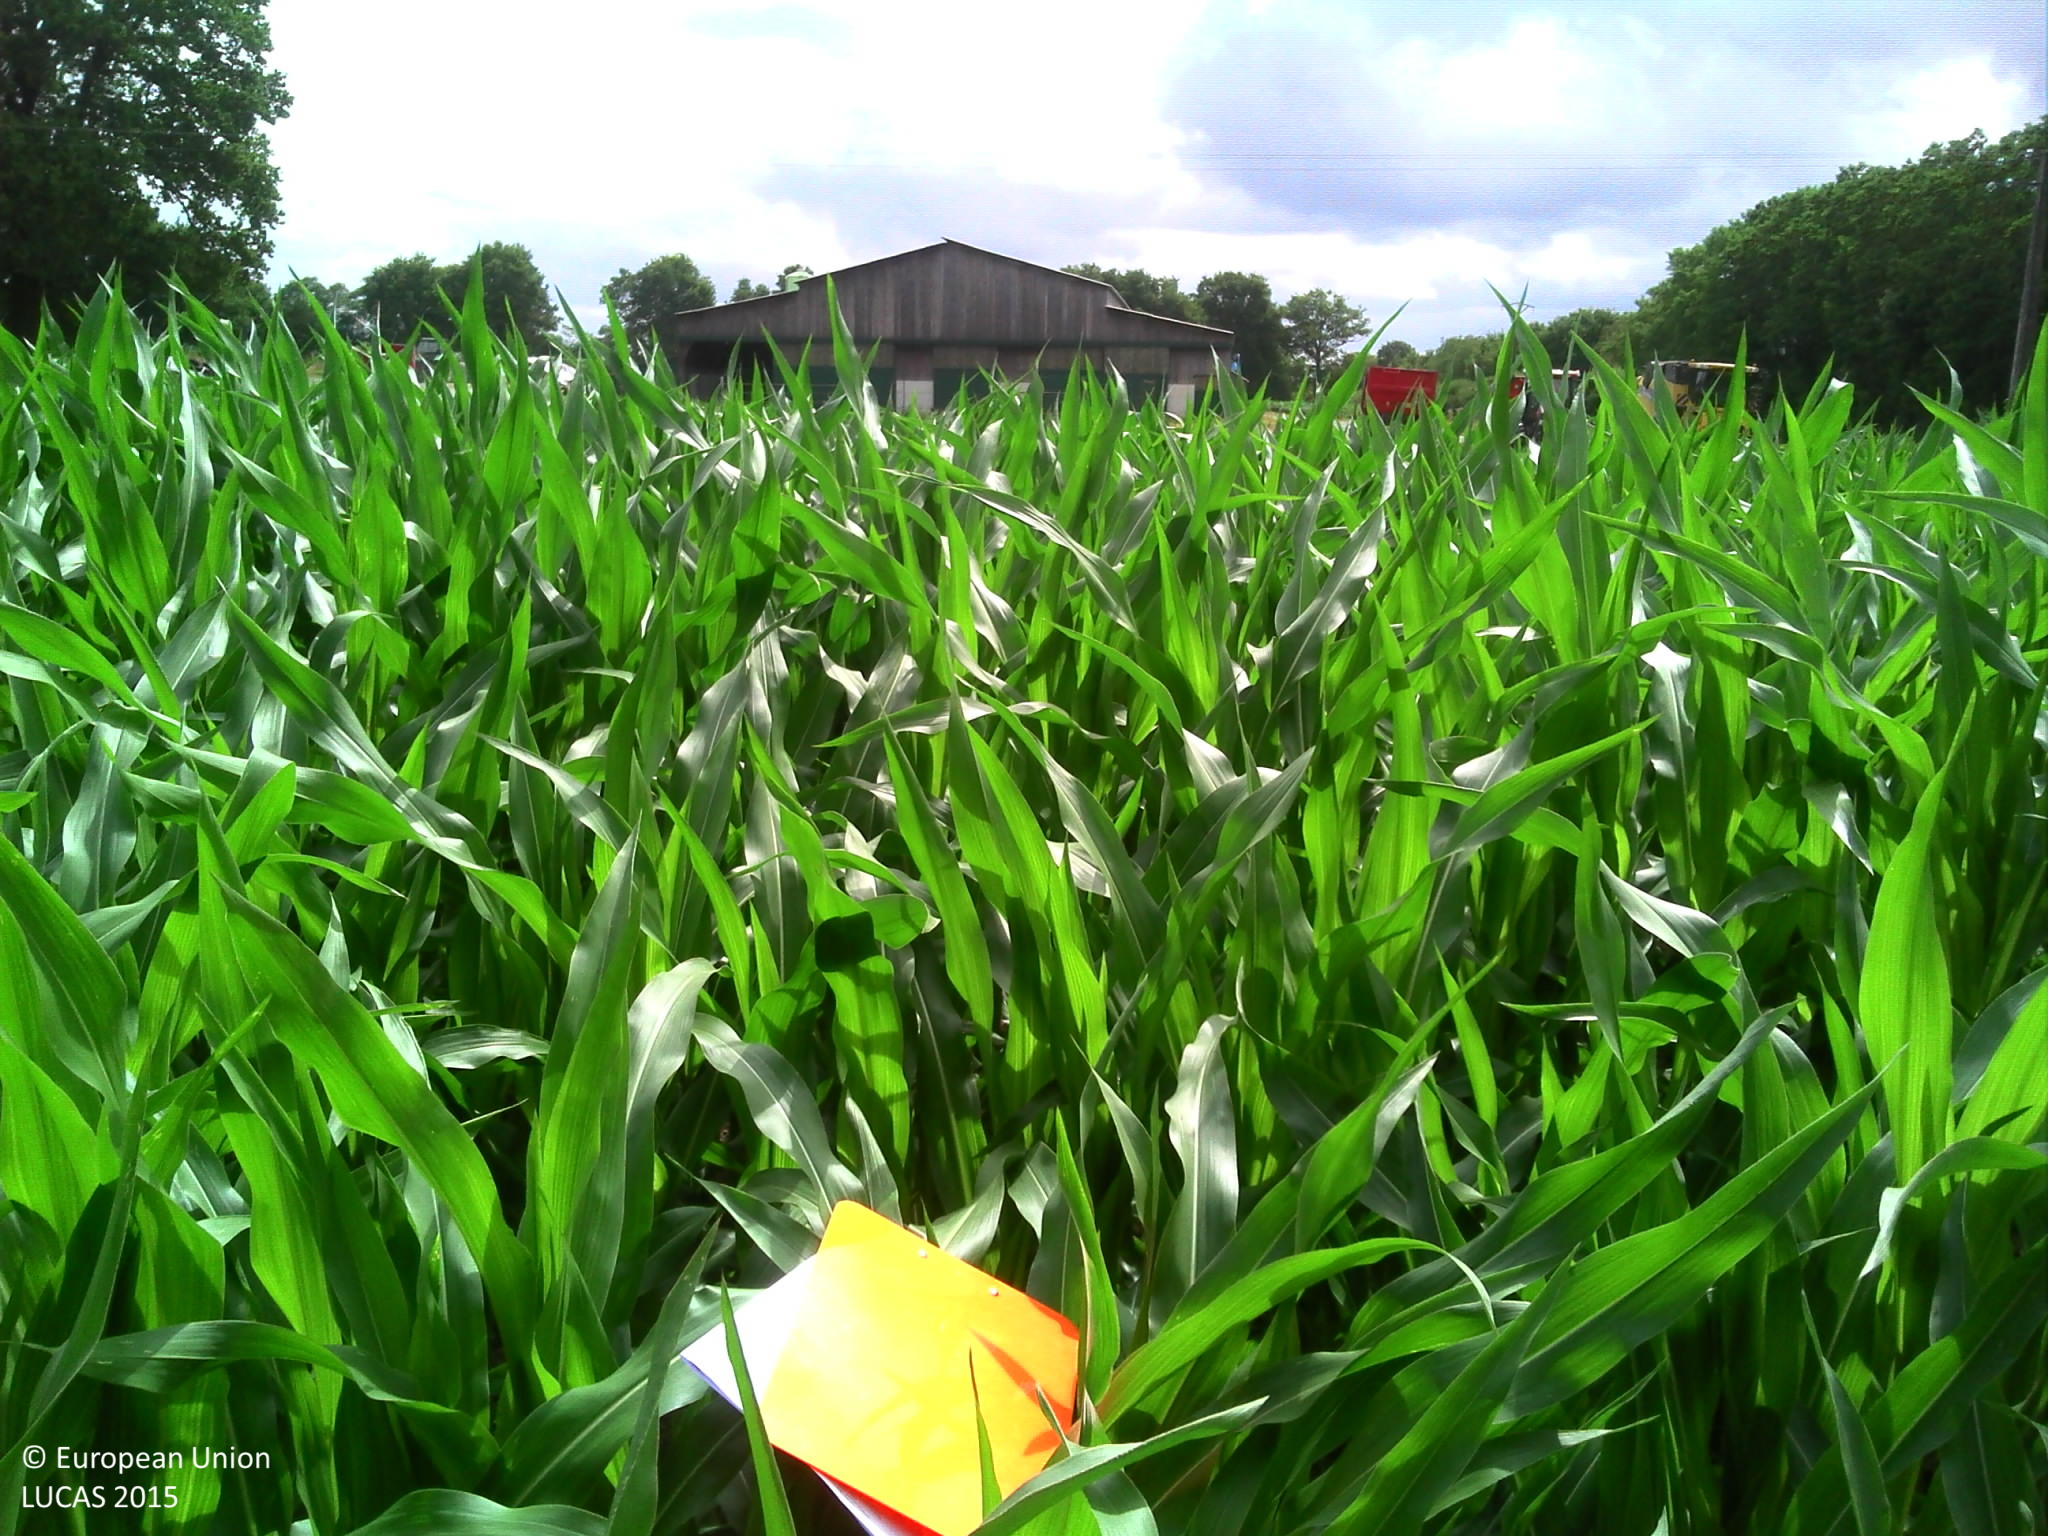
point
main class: Cropland
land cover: Maize
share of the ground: > 75 %
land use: Agriculture (excluding fallow land and kitchen gardens)
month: July
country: FR
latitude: 47.5799
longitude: -1.8677
